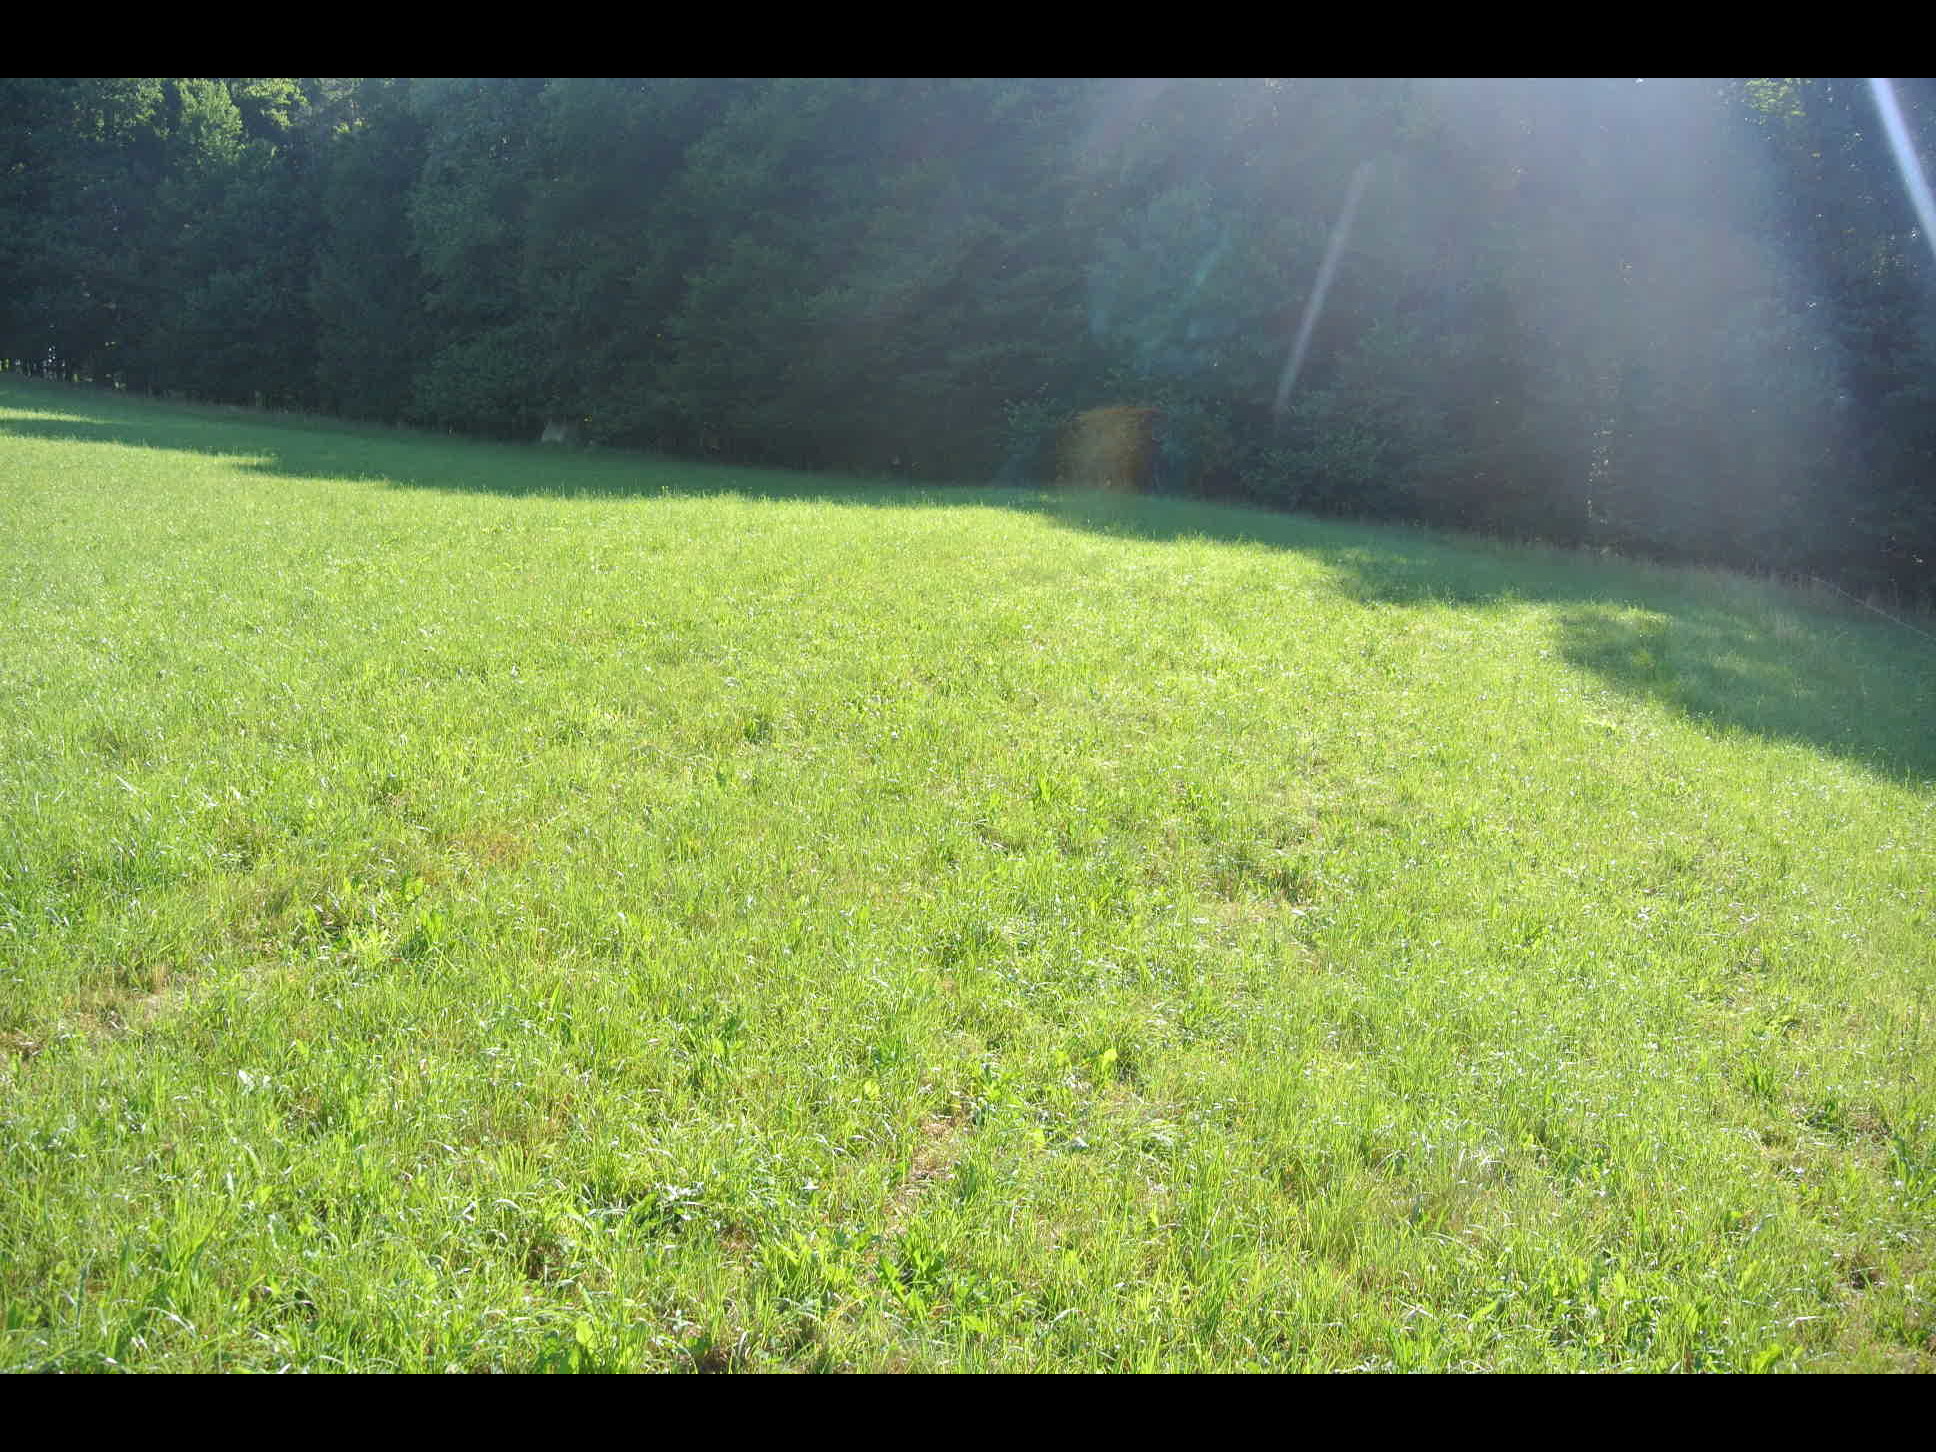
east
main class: Grassland
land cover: Grassland without tree/shrub cover
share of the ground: > 75 %
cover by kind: herbaceous plants 100 %
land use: Agriculture (excluding fallow land and kitchen gardens)
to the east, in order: Grassland without tree/shrub cover; Grassland with sparse tree/shrub cover; Grassland without tree/shrub cover; Fences; Grassland without tree/shrub cover; Spruce dominated mixed woodland; Fences; Spruce dominated mixed woodland; Spruce dominated coniferous woodland
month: July
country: AT
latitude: 48.0895
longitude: 15.7894
